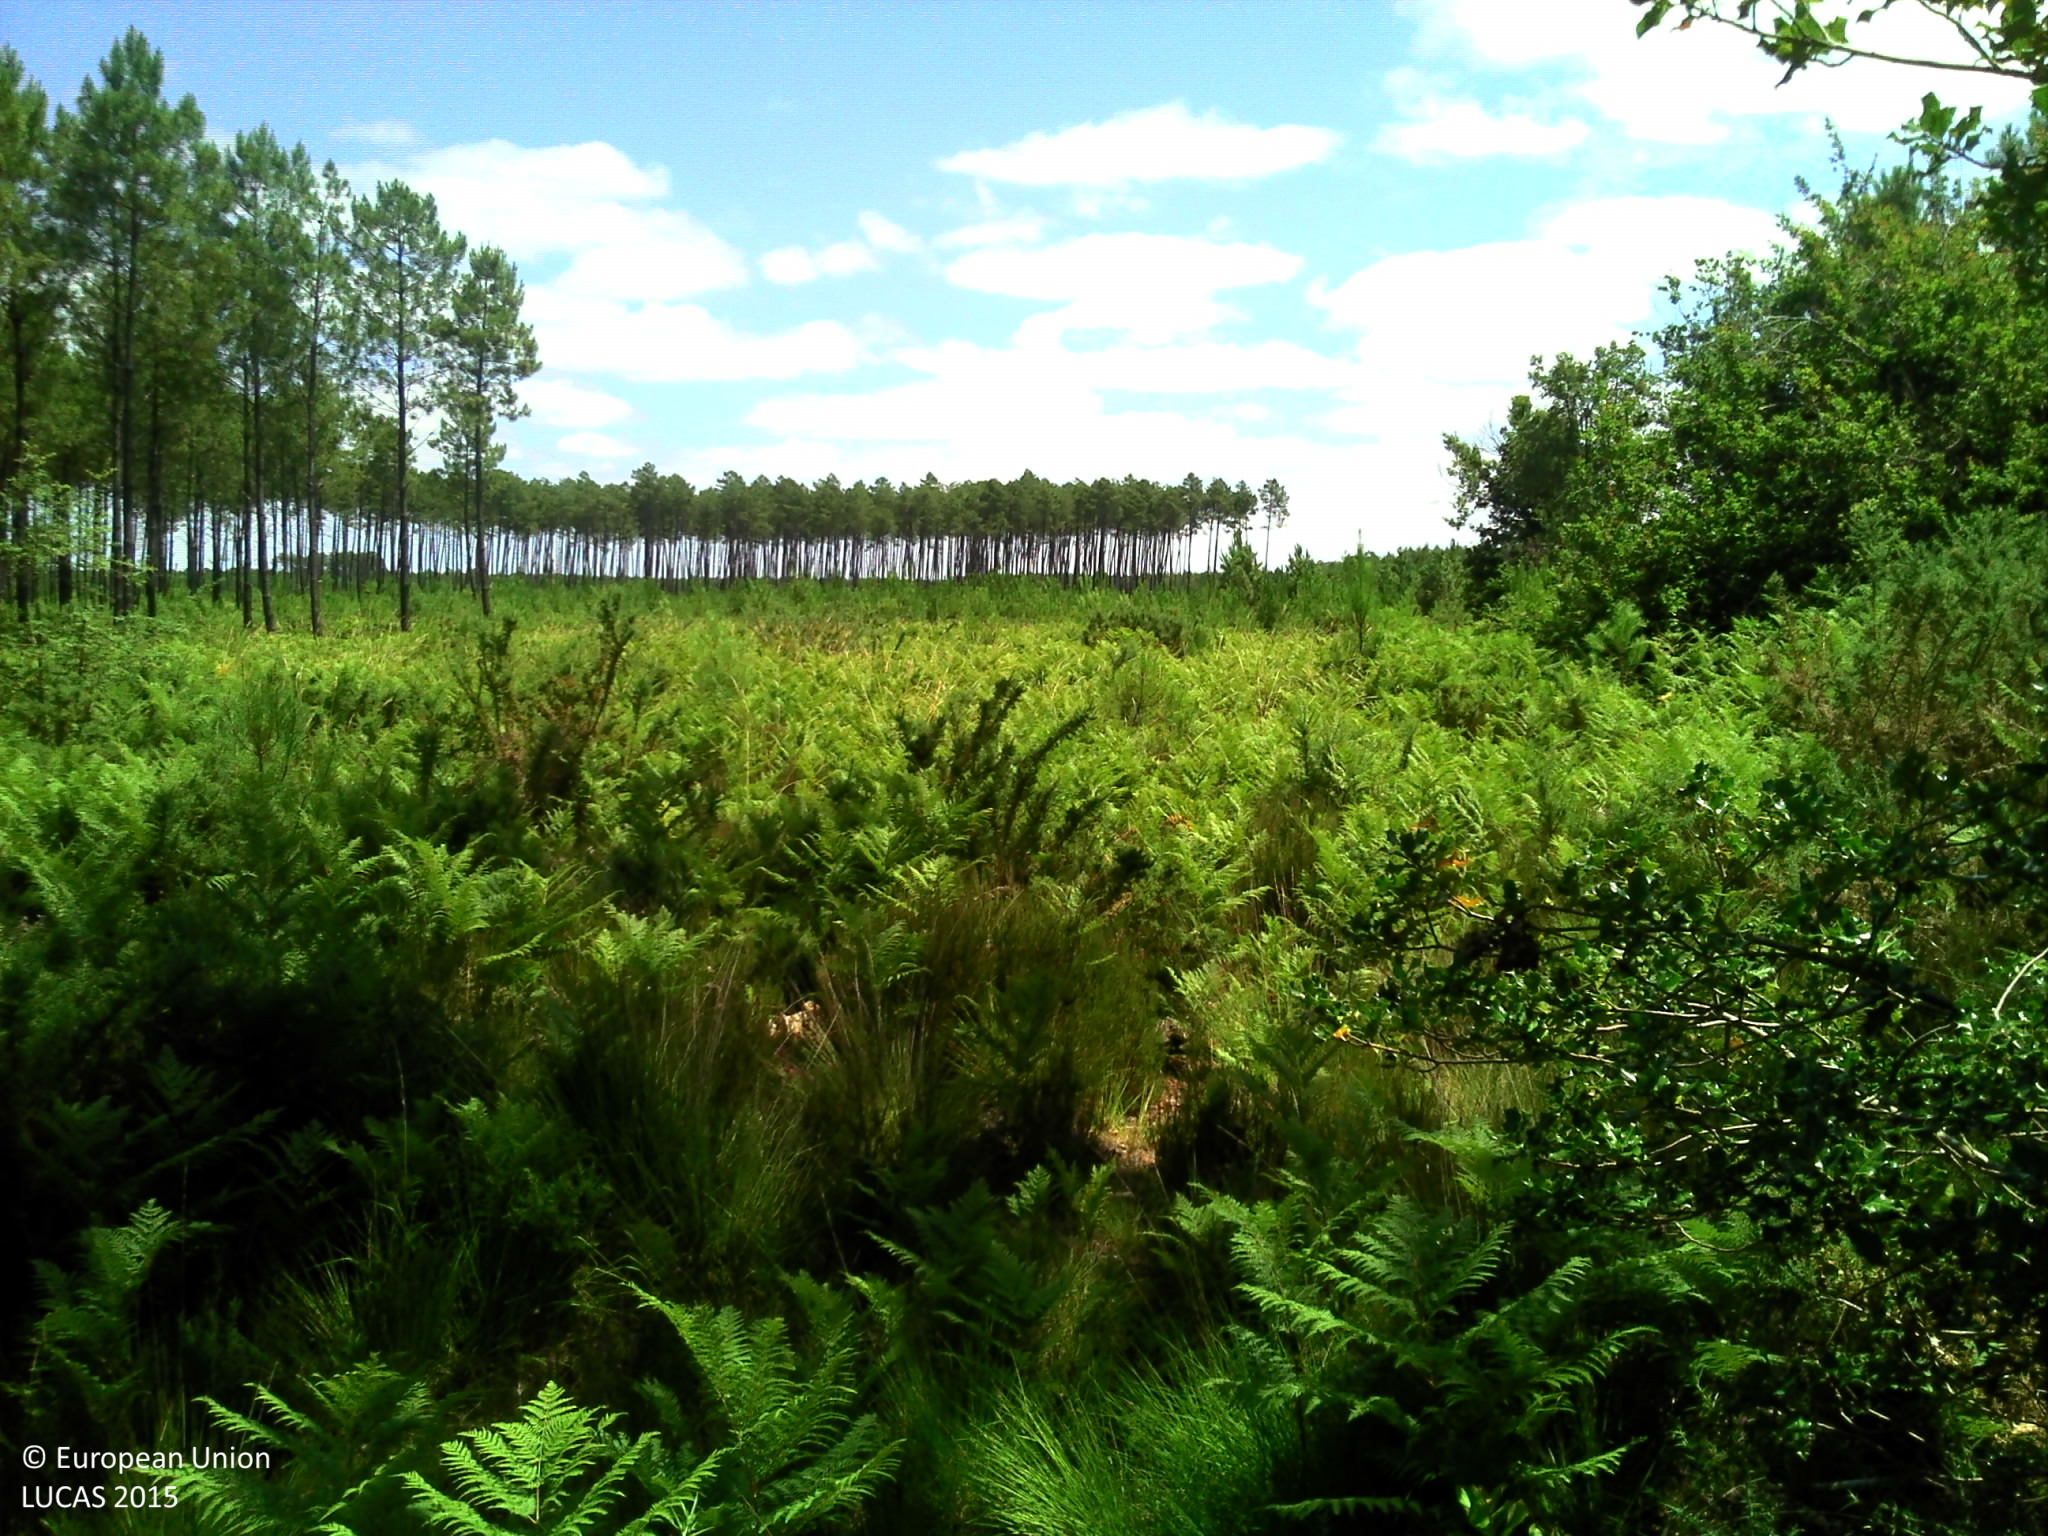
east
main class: Woodland
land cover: Pine dominated mixed woodland
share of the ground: > 75 %
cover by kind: coniferous forest trees 40 %, broadleaved forest trees 40 %, shrubs 10 %, herbaceous plants 10 %
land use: Forestry
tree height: > 5 m
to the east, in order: Pine dominated mixed woodland; Spontaneously vegetated surfaces; Pine dominated coniferous woodland; Tracks; Pine dominated coniferous woodland
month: July
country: FR
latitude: 43.9787
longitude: -1.2014
